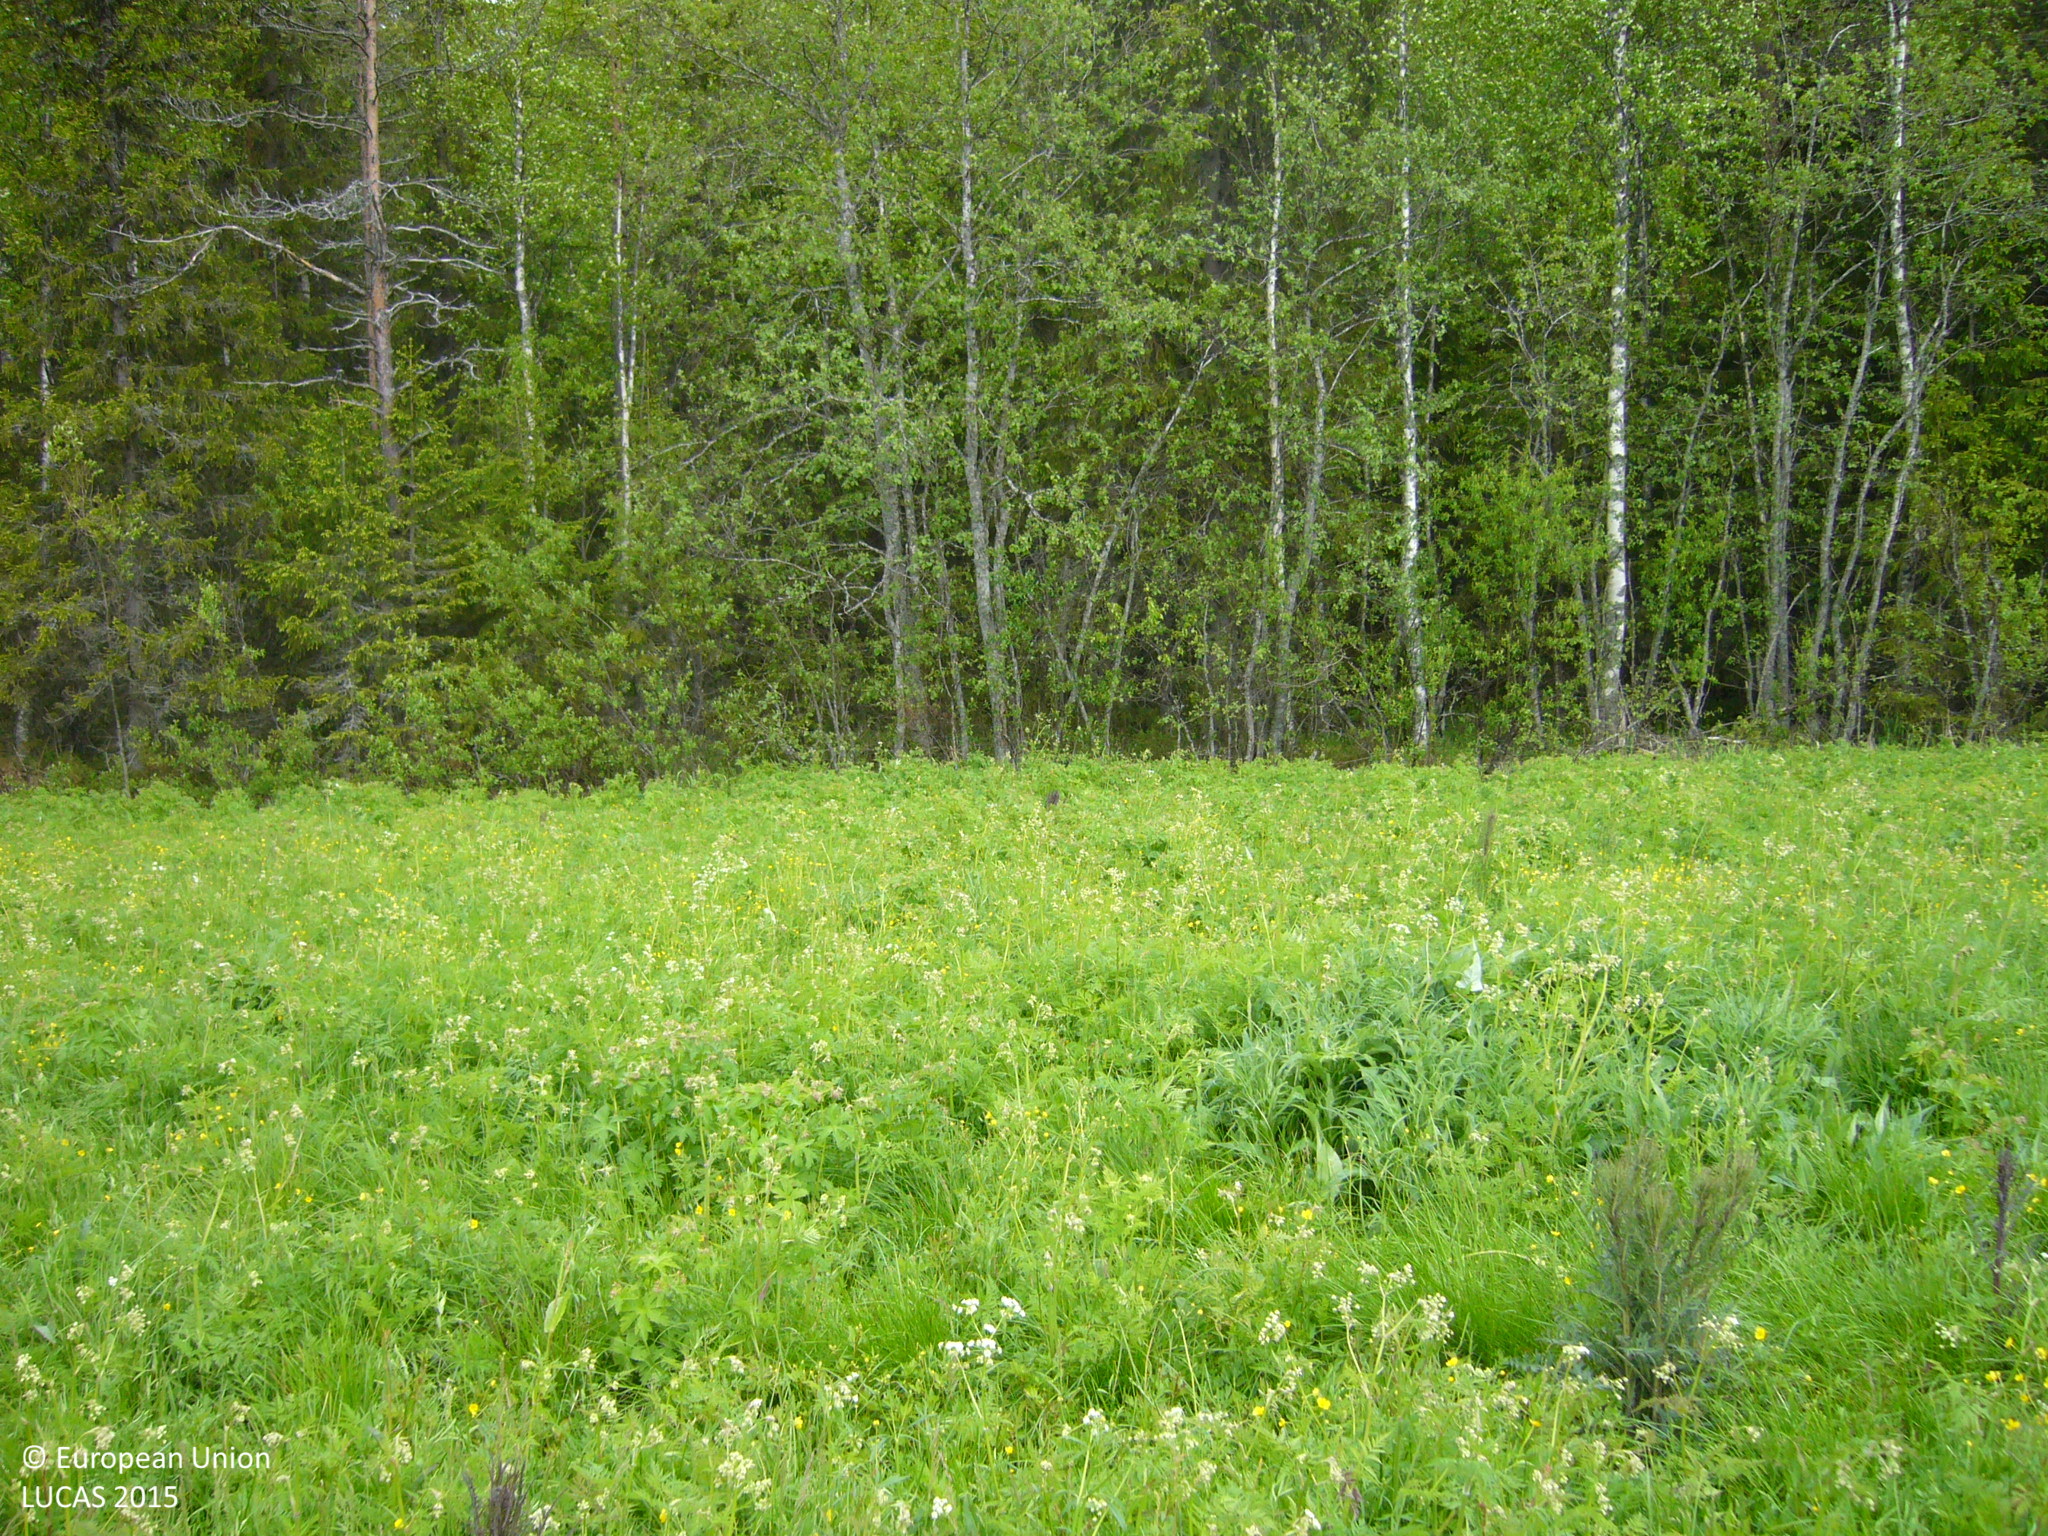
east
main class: Grassland
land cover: Spontaneously vegetated surfaces
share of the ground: > 75 %
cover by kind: herbaceous plants 100 %
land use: Fallow land
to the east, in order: Spontaneously vegetated surfaces; Shruby margins; Ditches and canals; Spruce dominated mixed woodland; Tracks; Spruce dominated mixed woodland; Tracks; Spruce dominated mixed woodland; Ditches and canals; Spruce dominated coniferous woodland; Shruby margins; Ditches and canals; Grass margins; Paved roads, cycling and walking lanes; Grass margins; Ditches and canals; Shruby margins; Spruce dominated mixed woodland; Tracks; Pine dominated mixed woodland
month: June
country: FI
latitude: 63.8903
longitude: 27.0621
